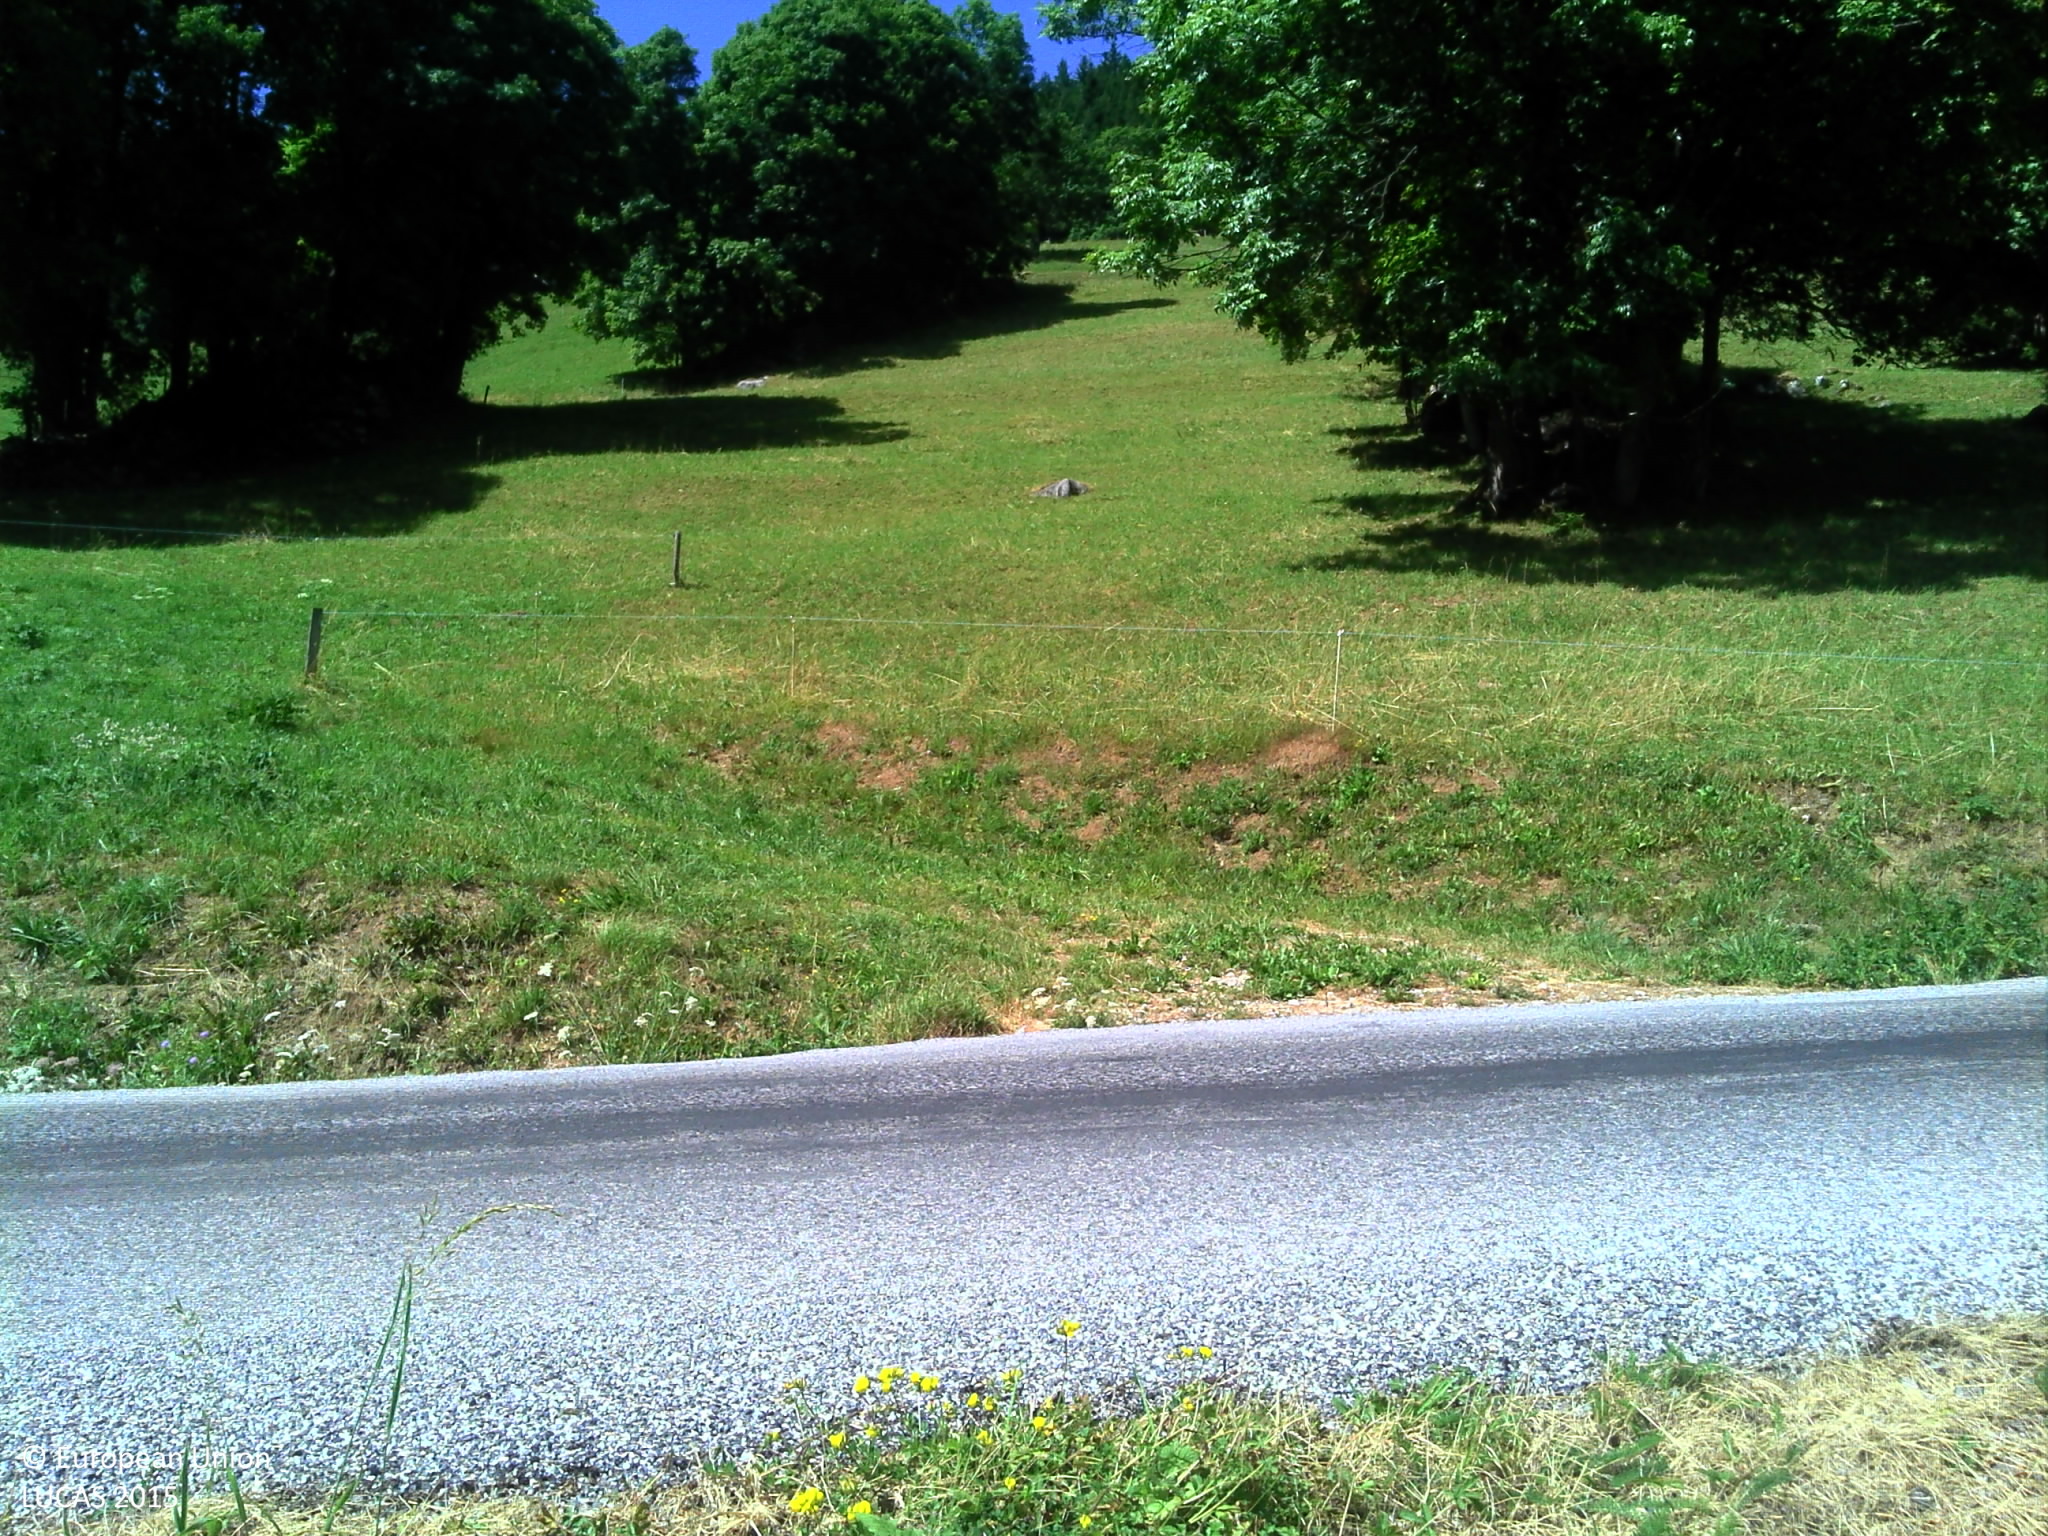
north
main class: Grassland
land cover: Grassland with sparse tree/shrub cover
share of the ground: > 75 %
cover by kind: herbaceous plants 95 %, broadleaved forest trees 5 %
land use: Agriculture (excluding fallow land and kitchen gardens)
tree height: > 5 m
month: July
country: FR
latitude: 45.9139
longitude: 6.4585
